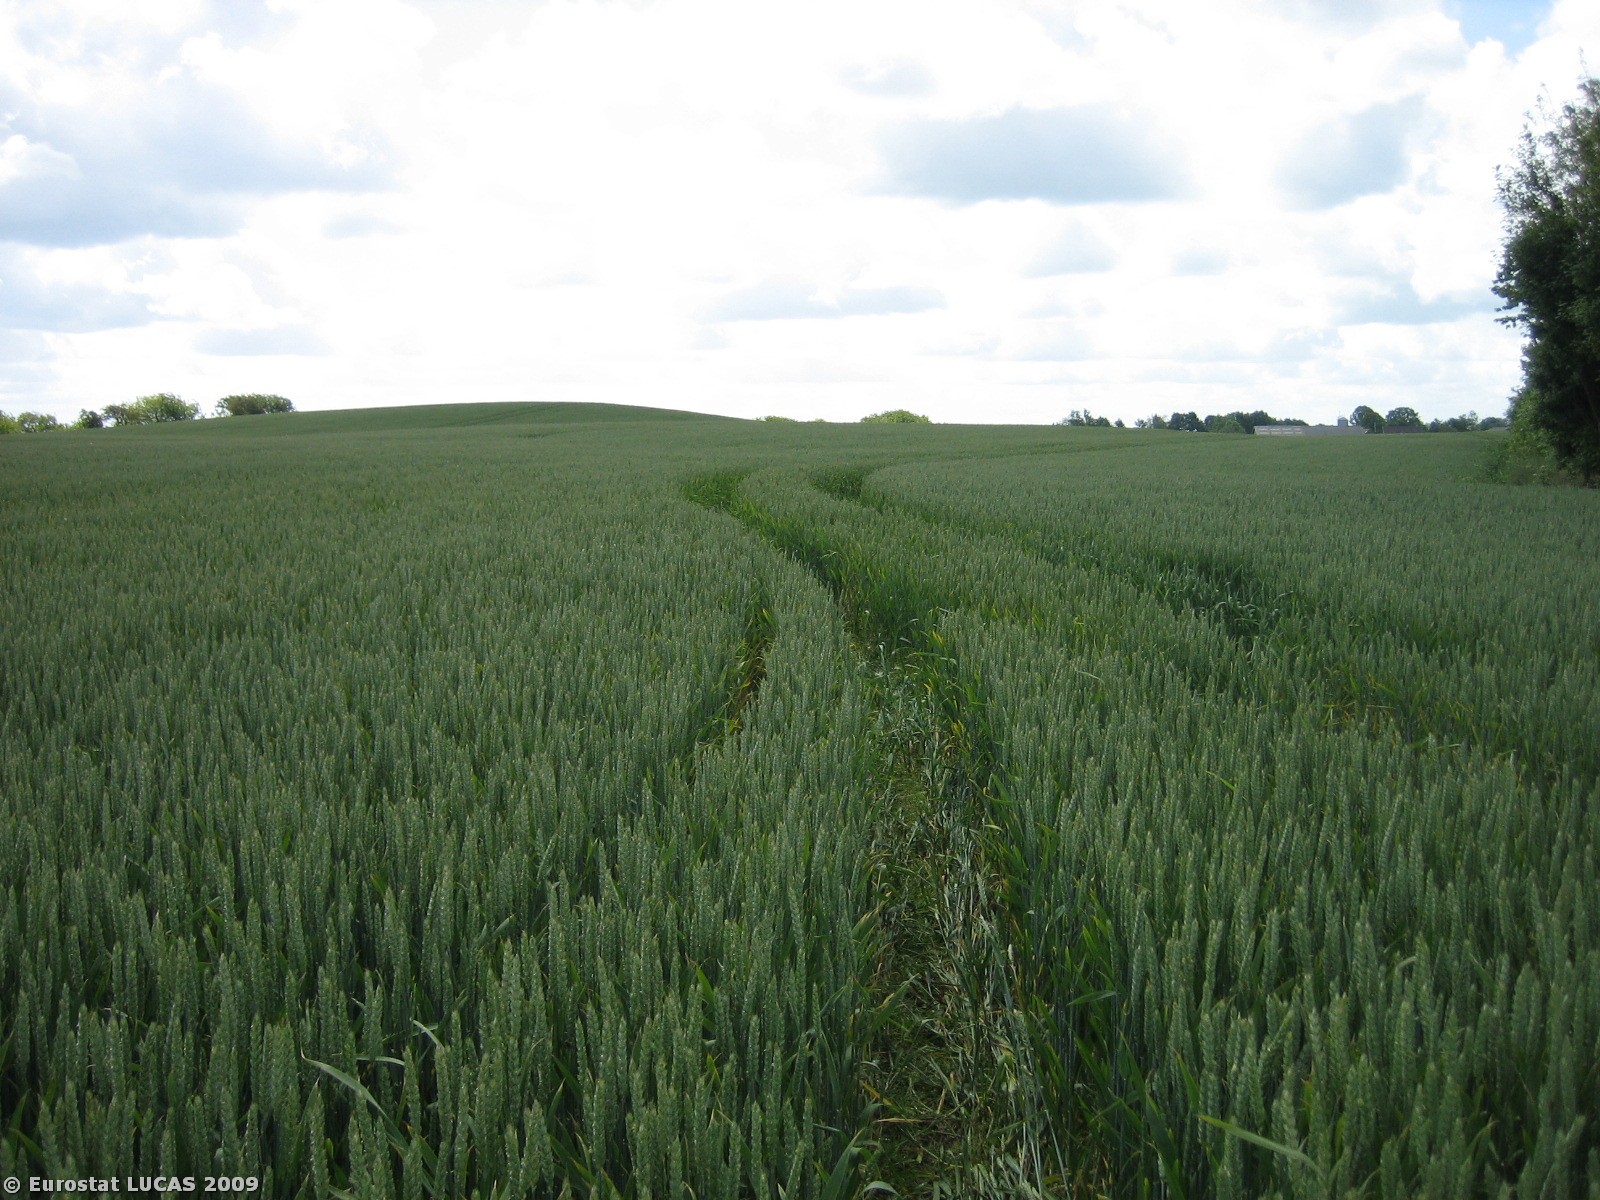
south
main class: Cropland
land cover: Common wheat
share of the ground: > 75 %
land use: Agriculture (excluding fallow land and kitchen gardens)
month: June
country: DK
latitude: 55.7006
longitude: 9.3165
